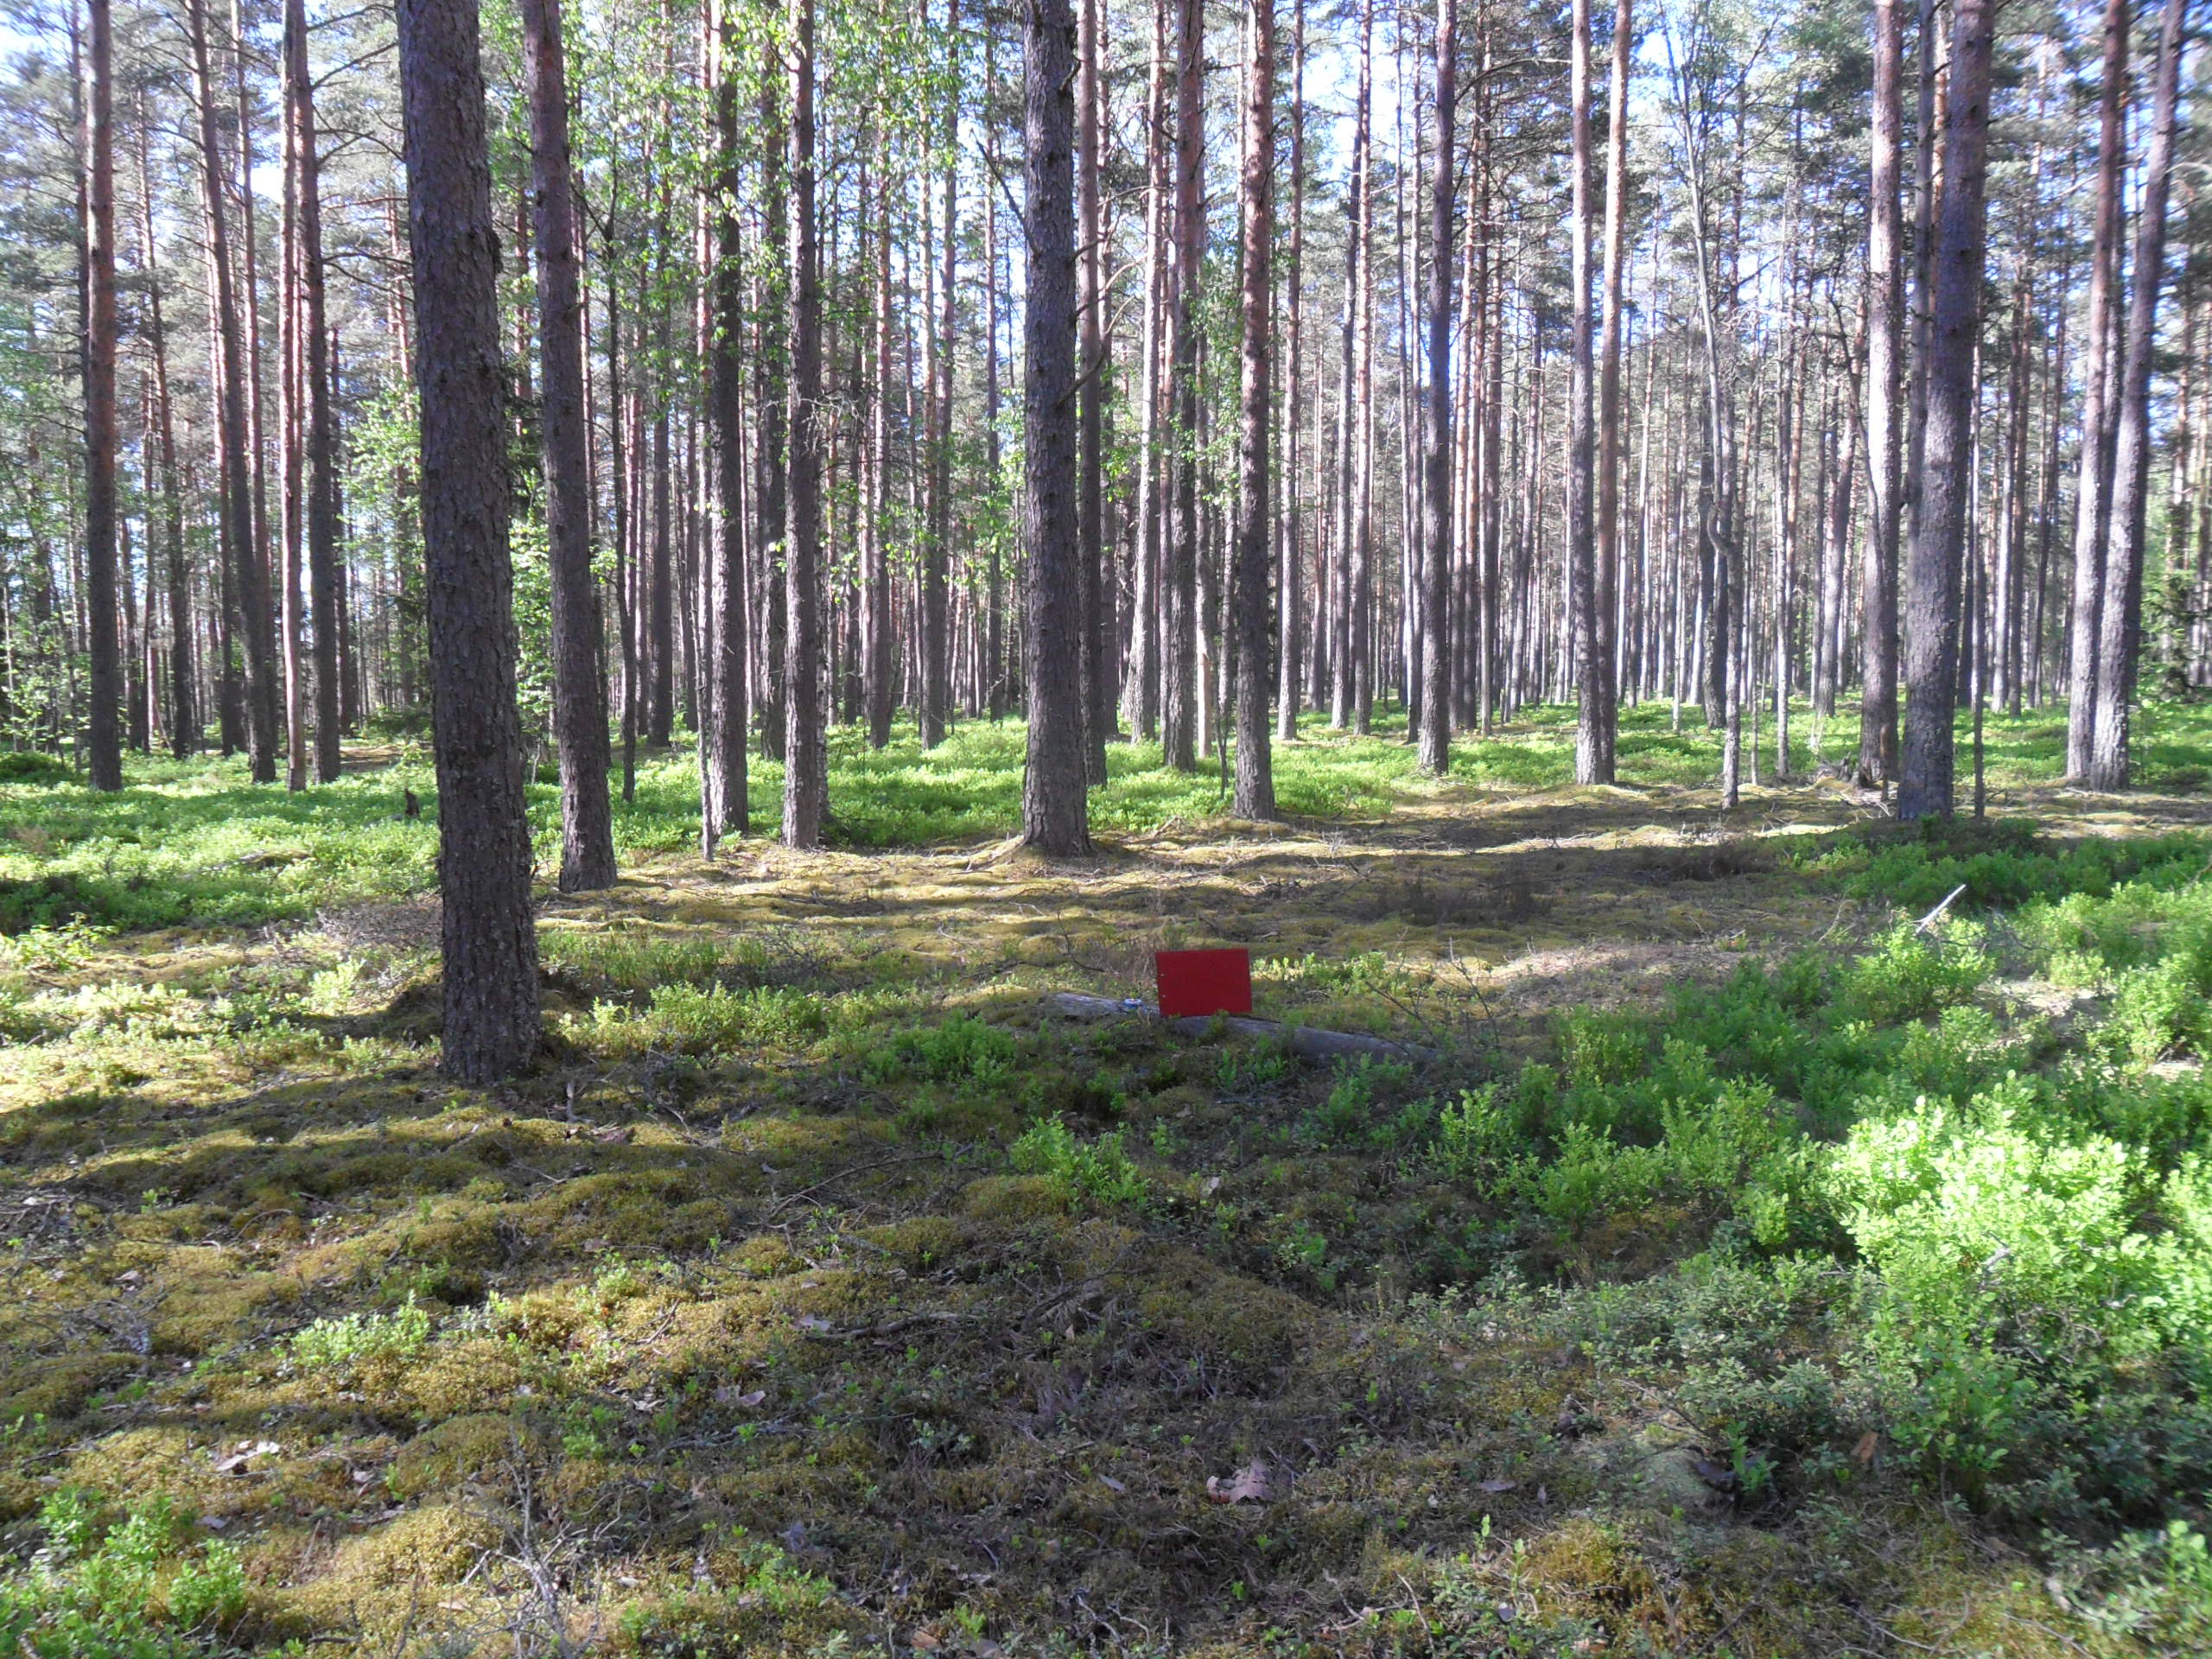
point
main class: Woodland
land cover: Pine dominated coniferous woodland
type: hemiboreal forest and nemoral coniferous forest and mixed broadleaved-coniferous forest
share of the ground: > 75 %
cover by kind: coniferous forest trees 90 %, herbaceous plants 10 %
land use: Forestry
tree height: > 5 m
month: June
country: LV
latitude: 57.5667
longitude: 22.2355
